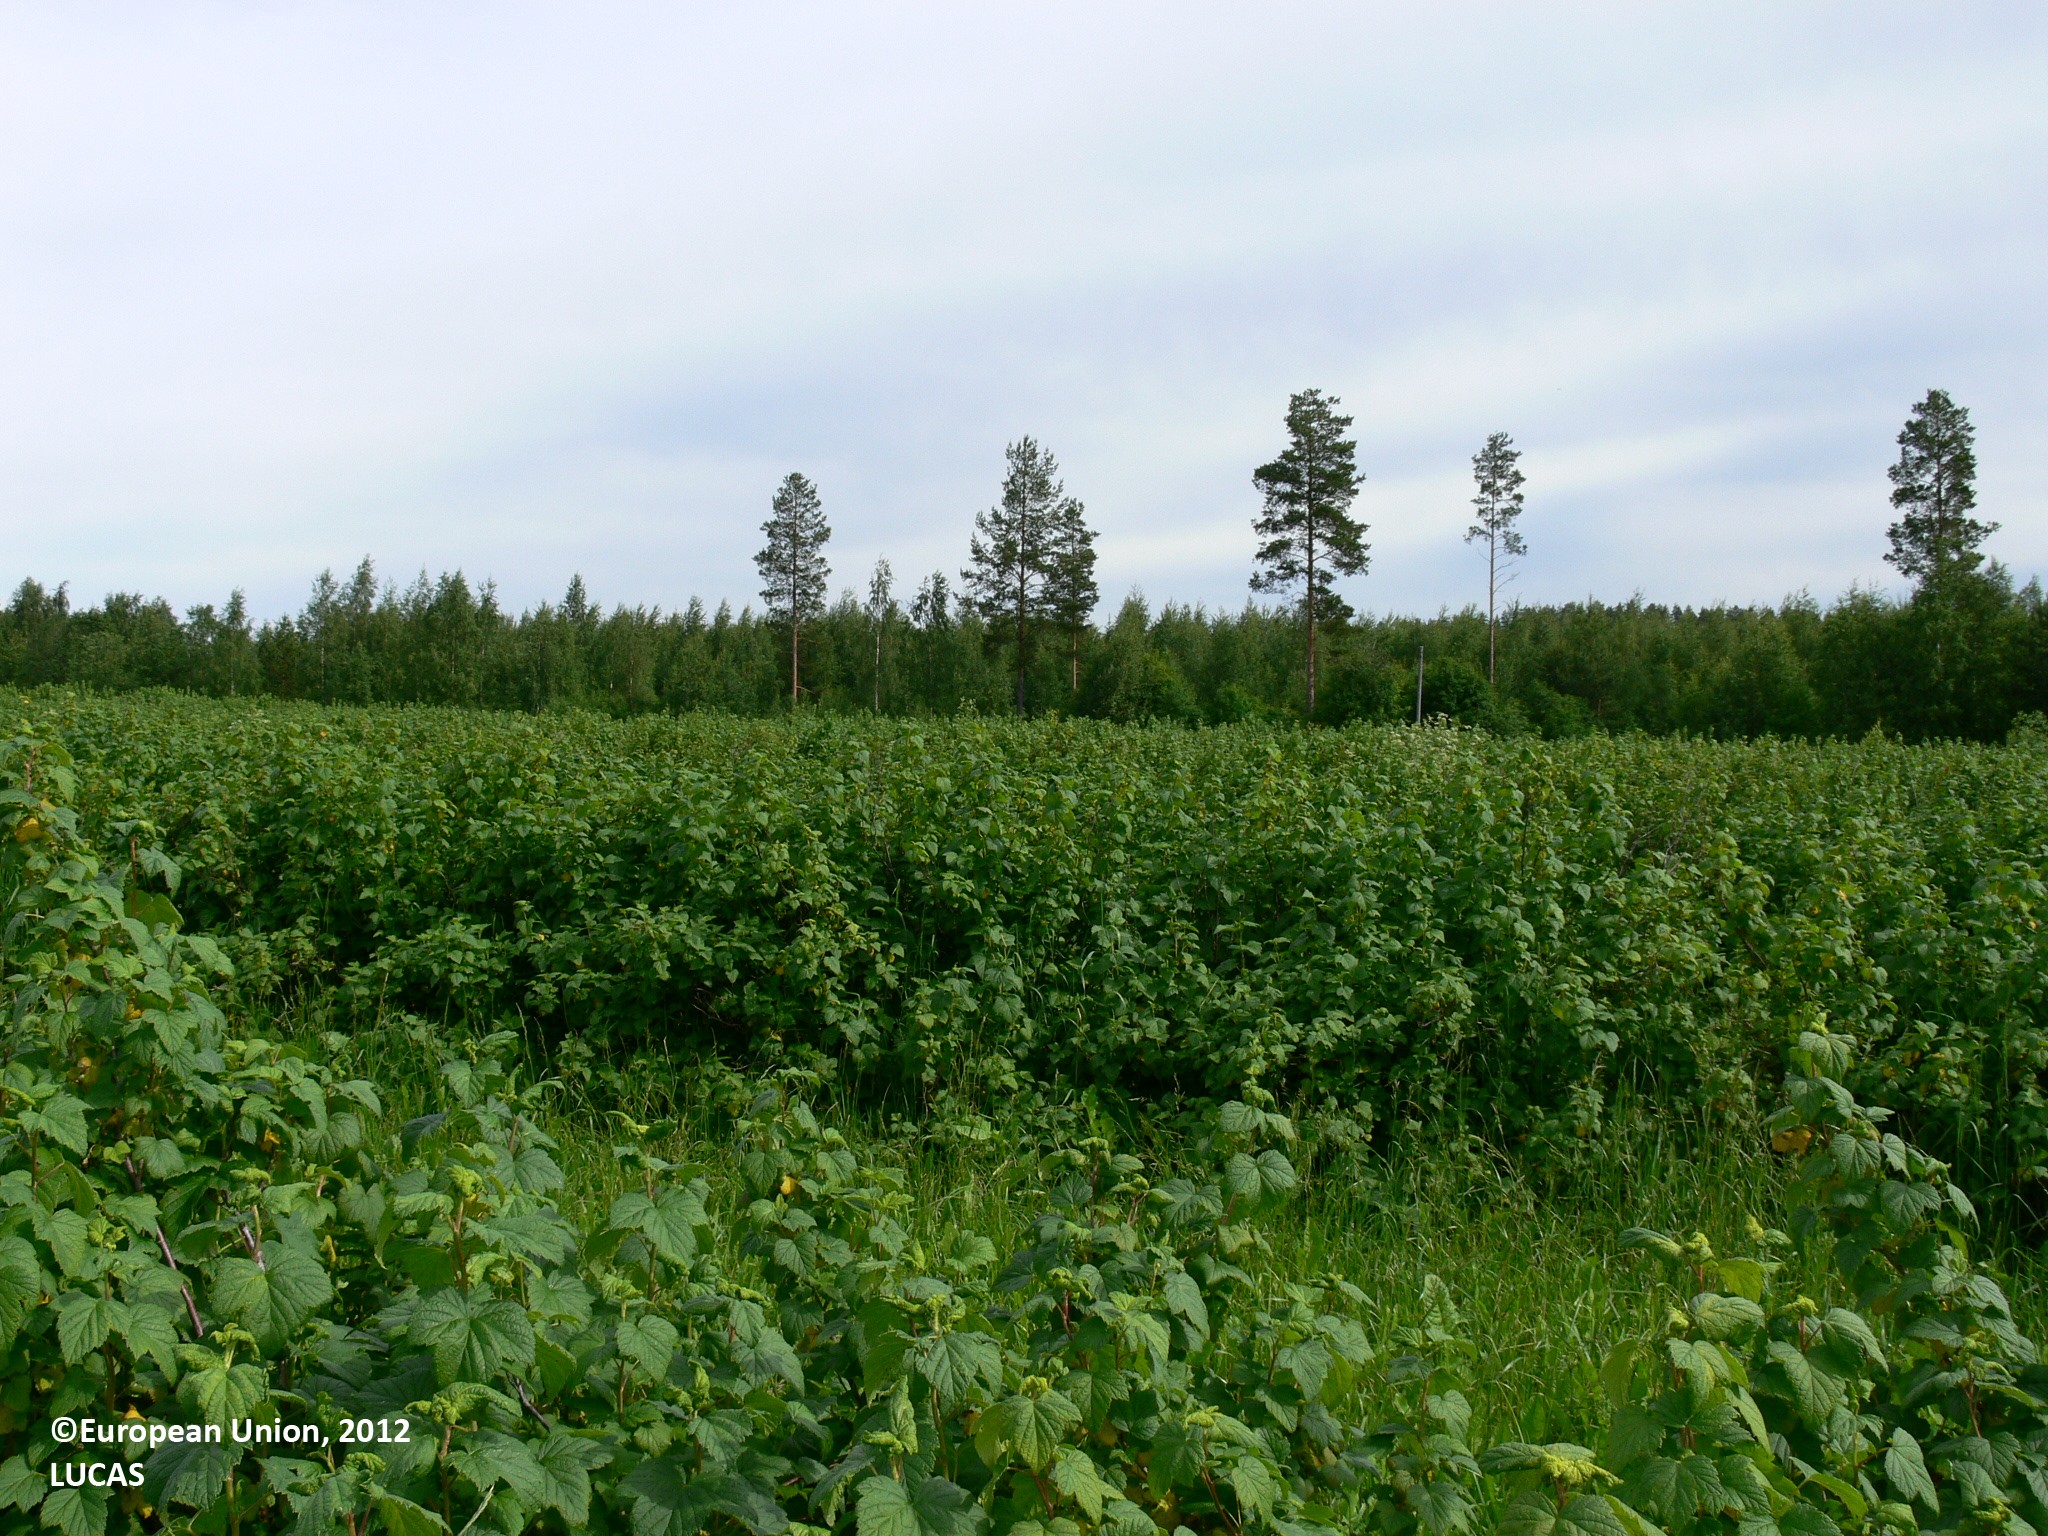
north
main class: Cropland
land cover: Other fruit trees and berries
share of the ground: 25 - 50 %
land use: Agriculture (excluding fallow land and kitchen gardens)
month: June
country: FI
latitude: 62.6445
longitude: 29.4908
